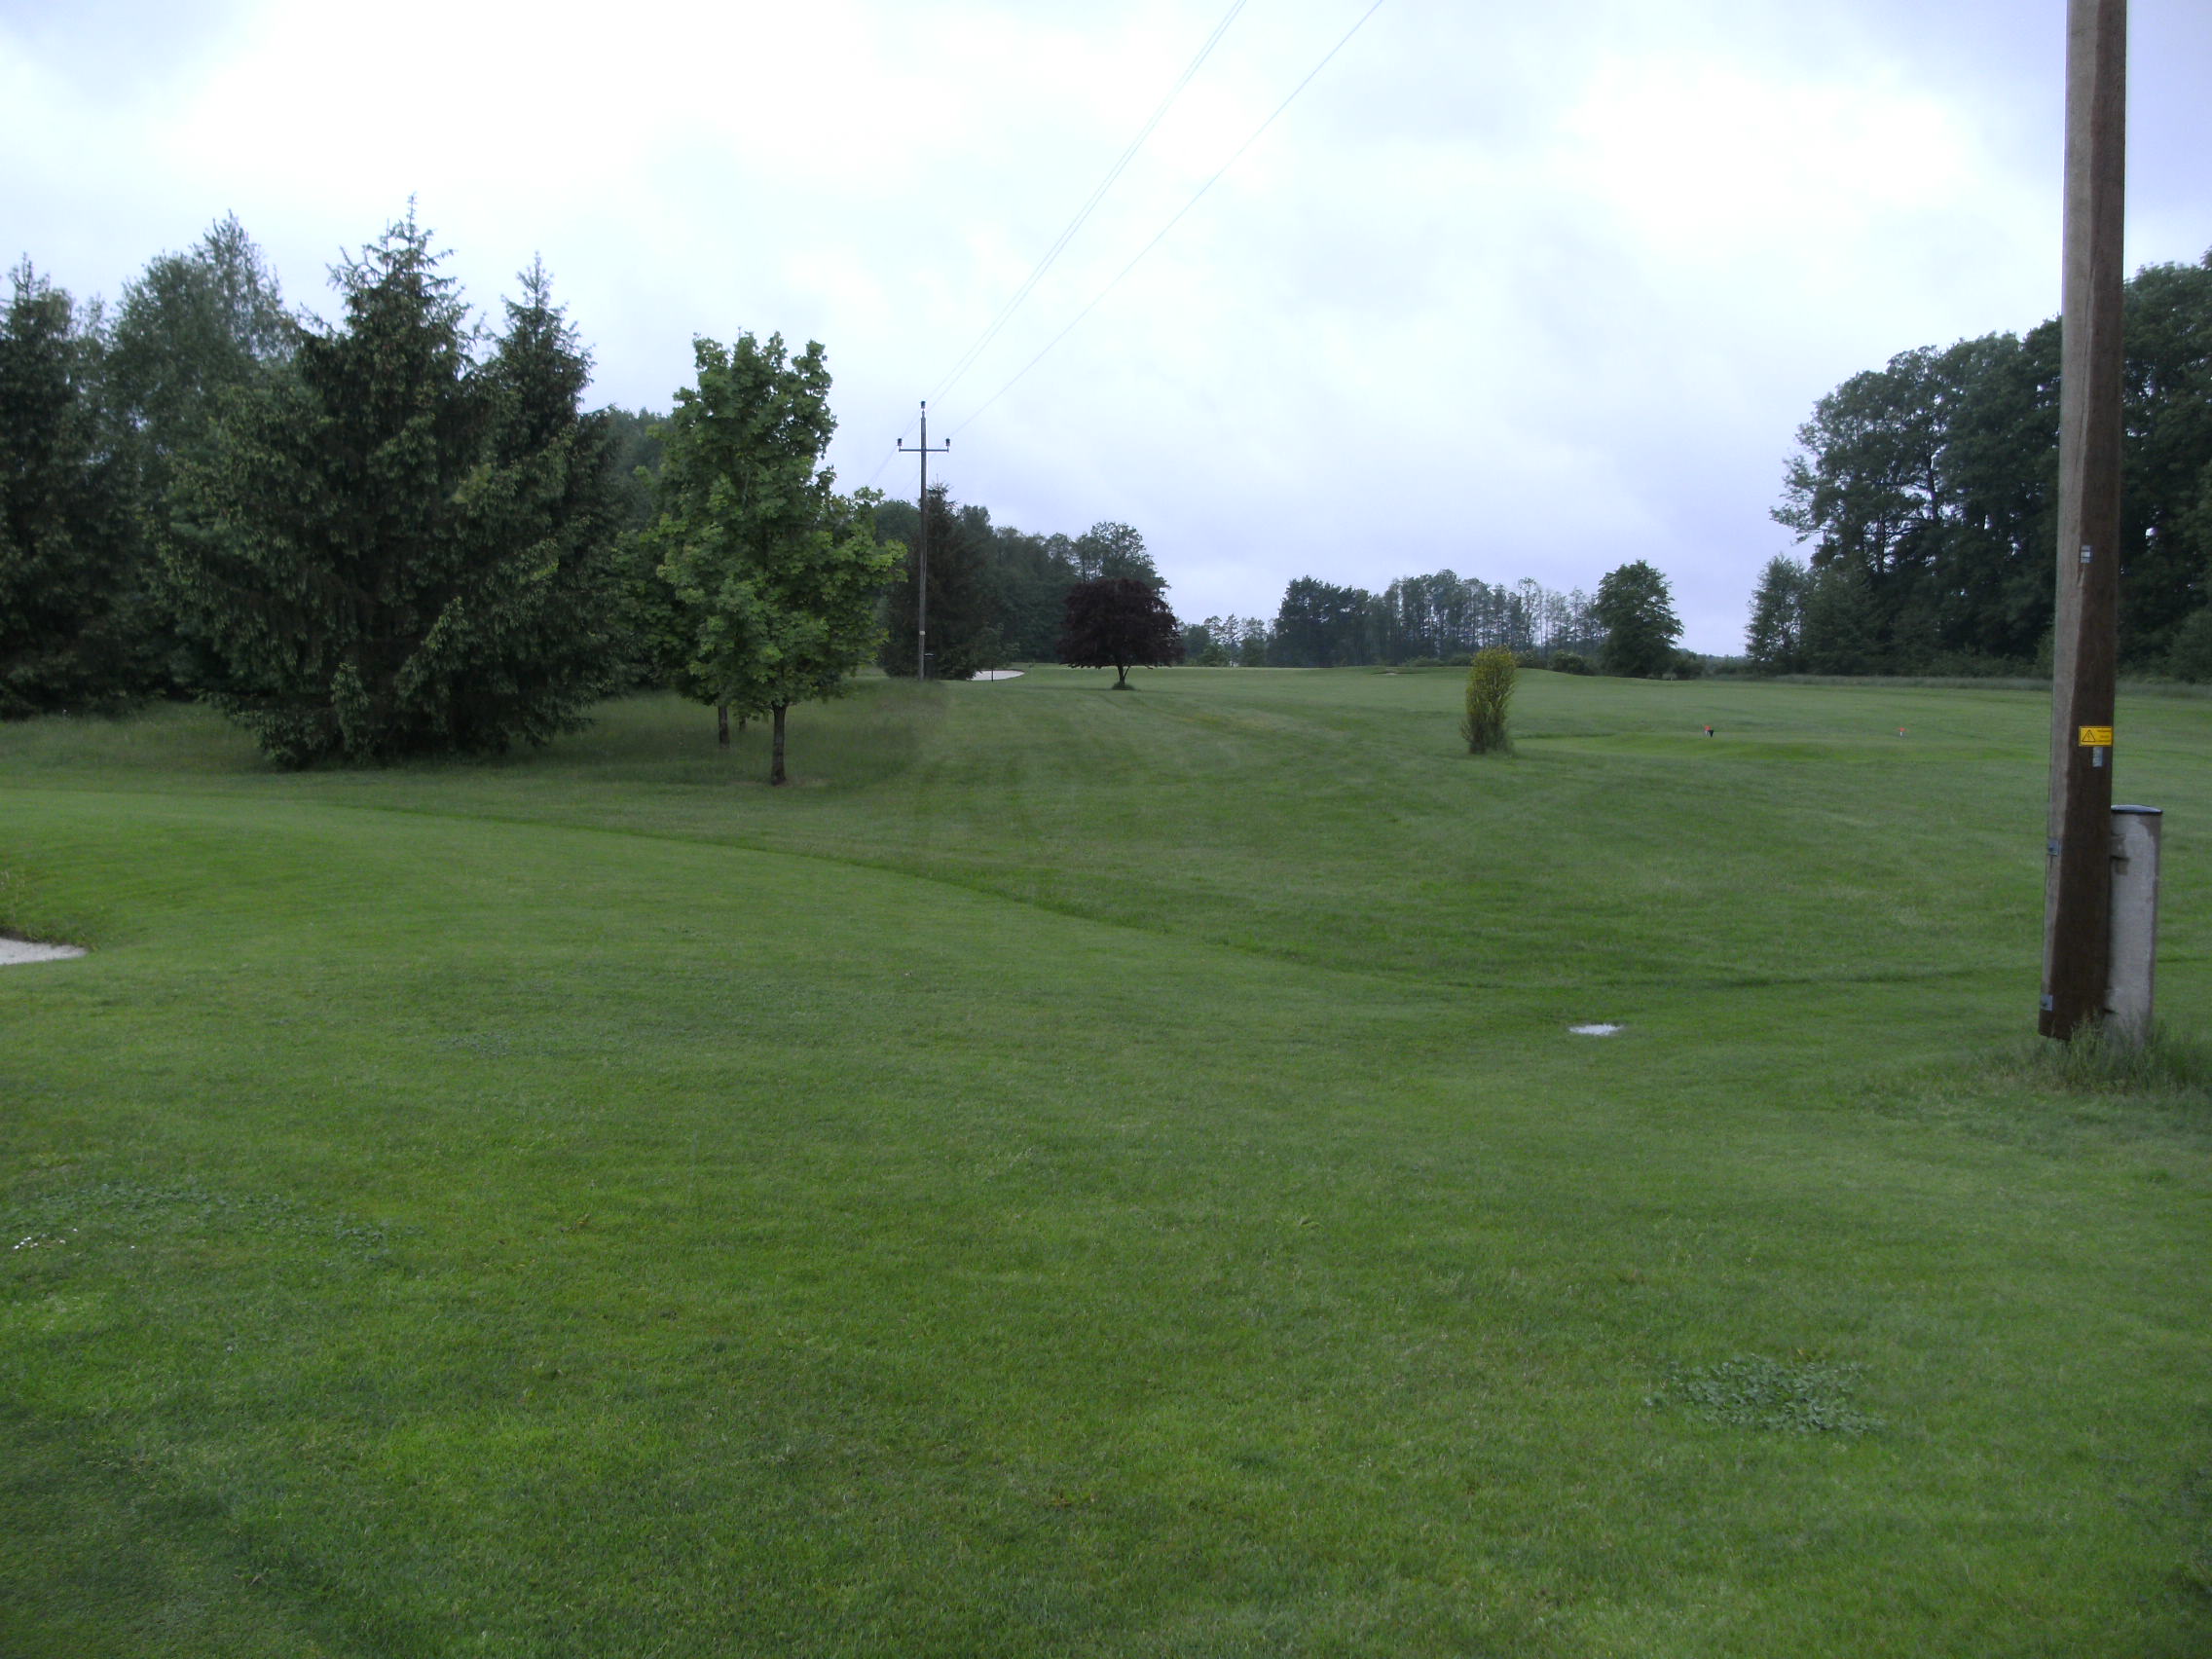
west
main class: Grassland
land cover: Grassland without tree/shrub cover
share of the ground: > 75 %
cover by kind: herbaceous plants 100 %
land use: Sport
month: May
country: AT
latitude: 48.3834
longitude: 13.5237
